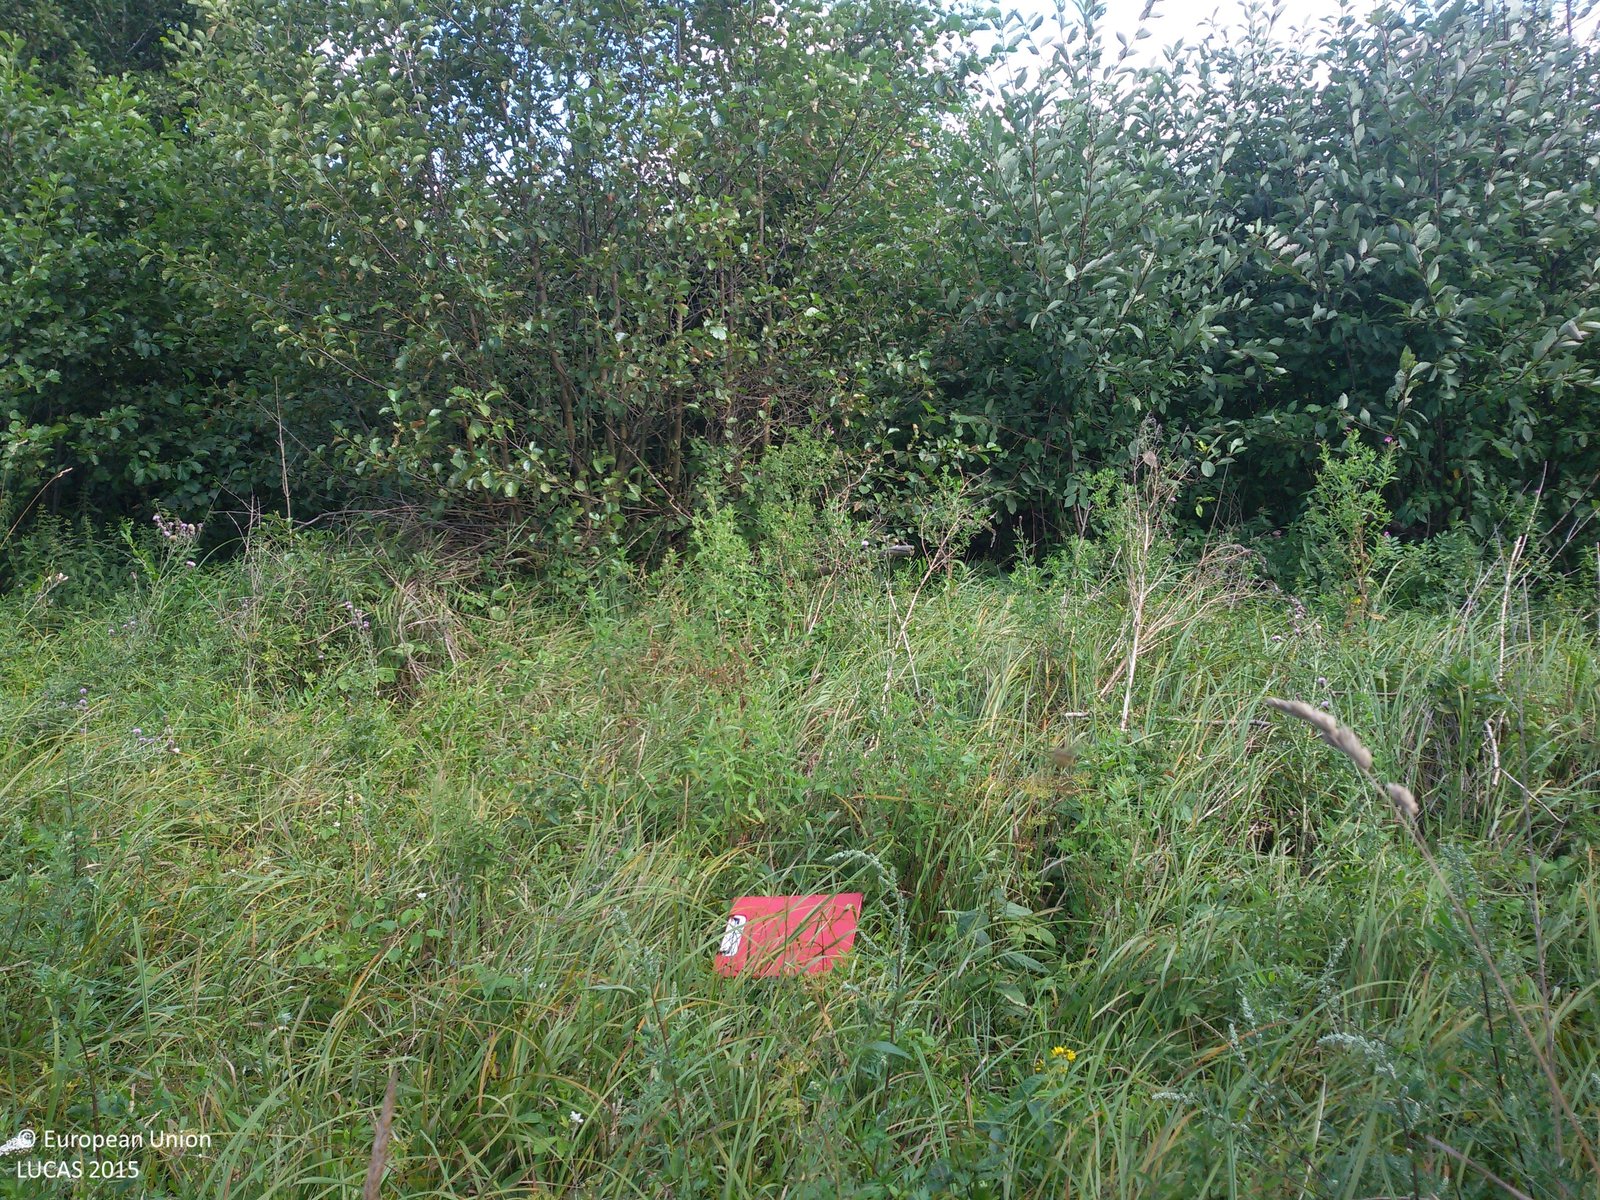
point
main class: Grassland
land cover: Spontaneously vegetated surfaces
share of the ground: > 75 %
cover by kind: herbaceous plants 95 %, shrubs 5 %
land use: Semi-natural and natural areas not in use
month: July
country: PL
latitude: 52.8932
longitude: 19.1355
